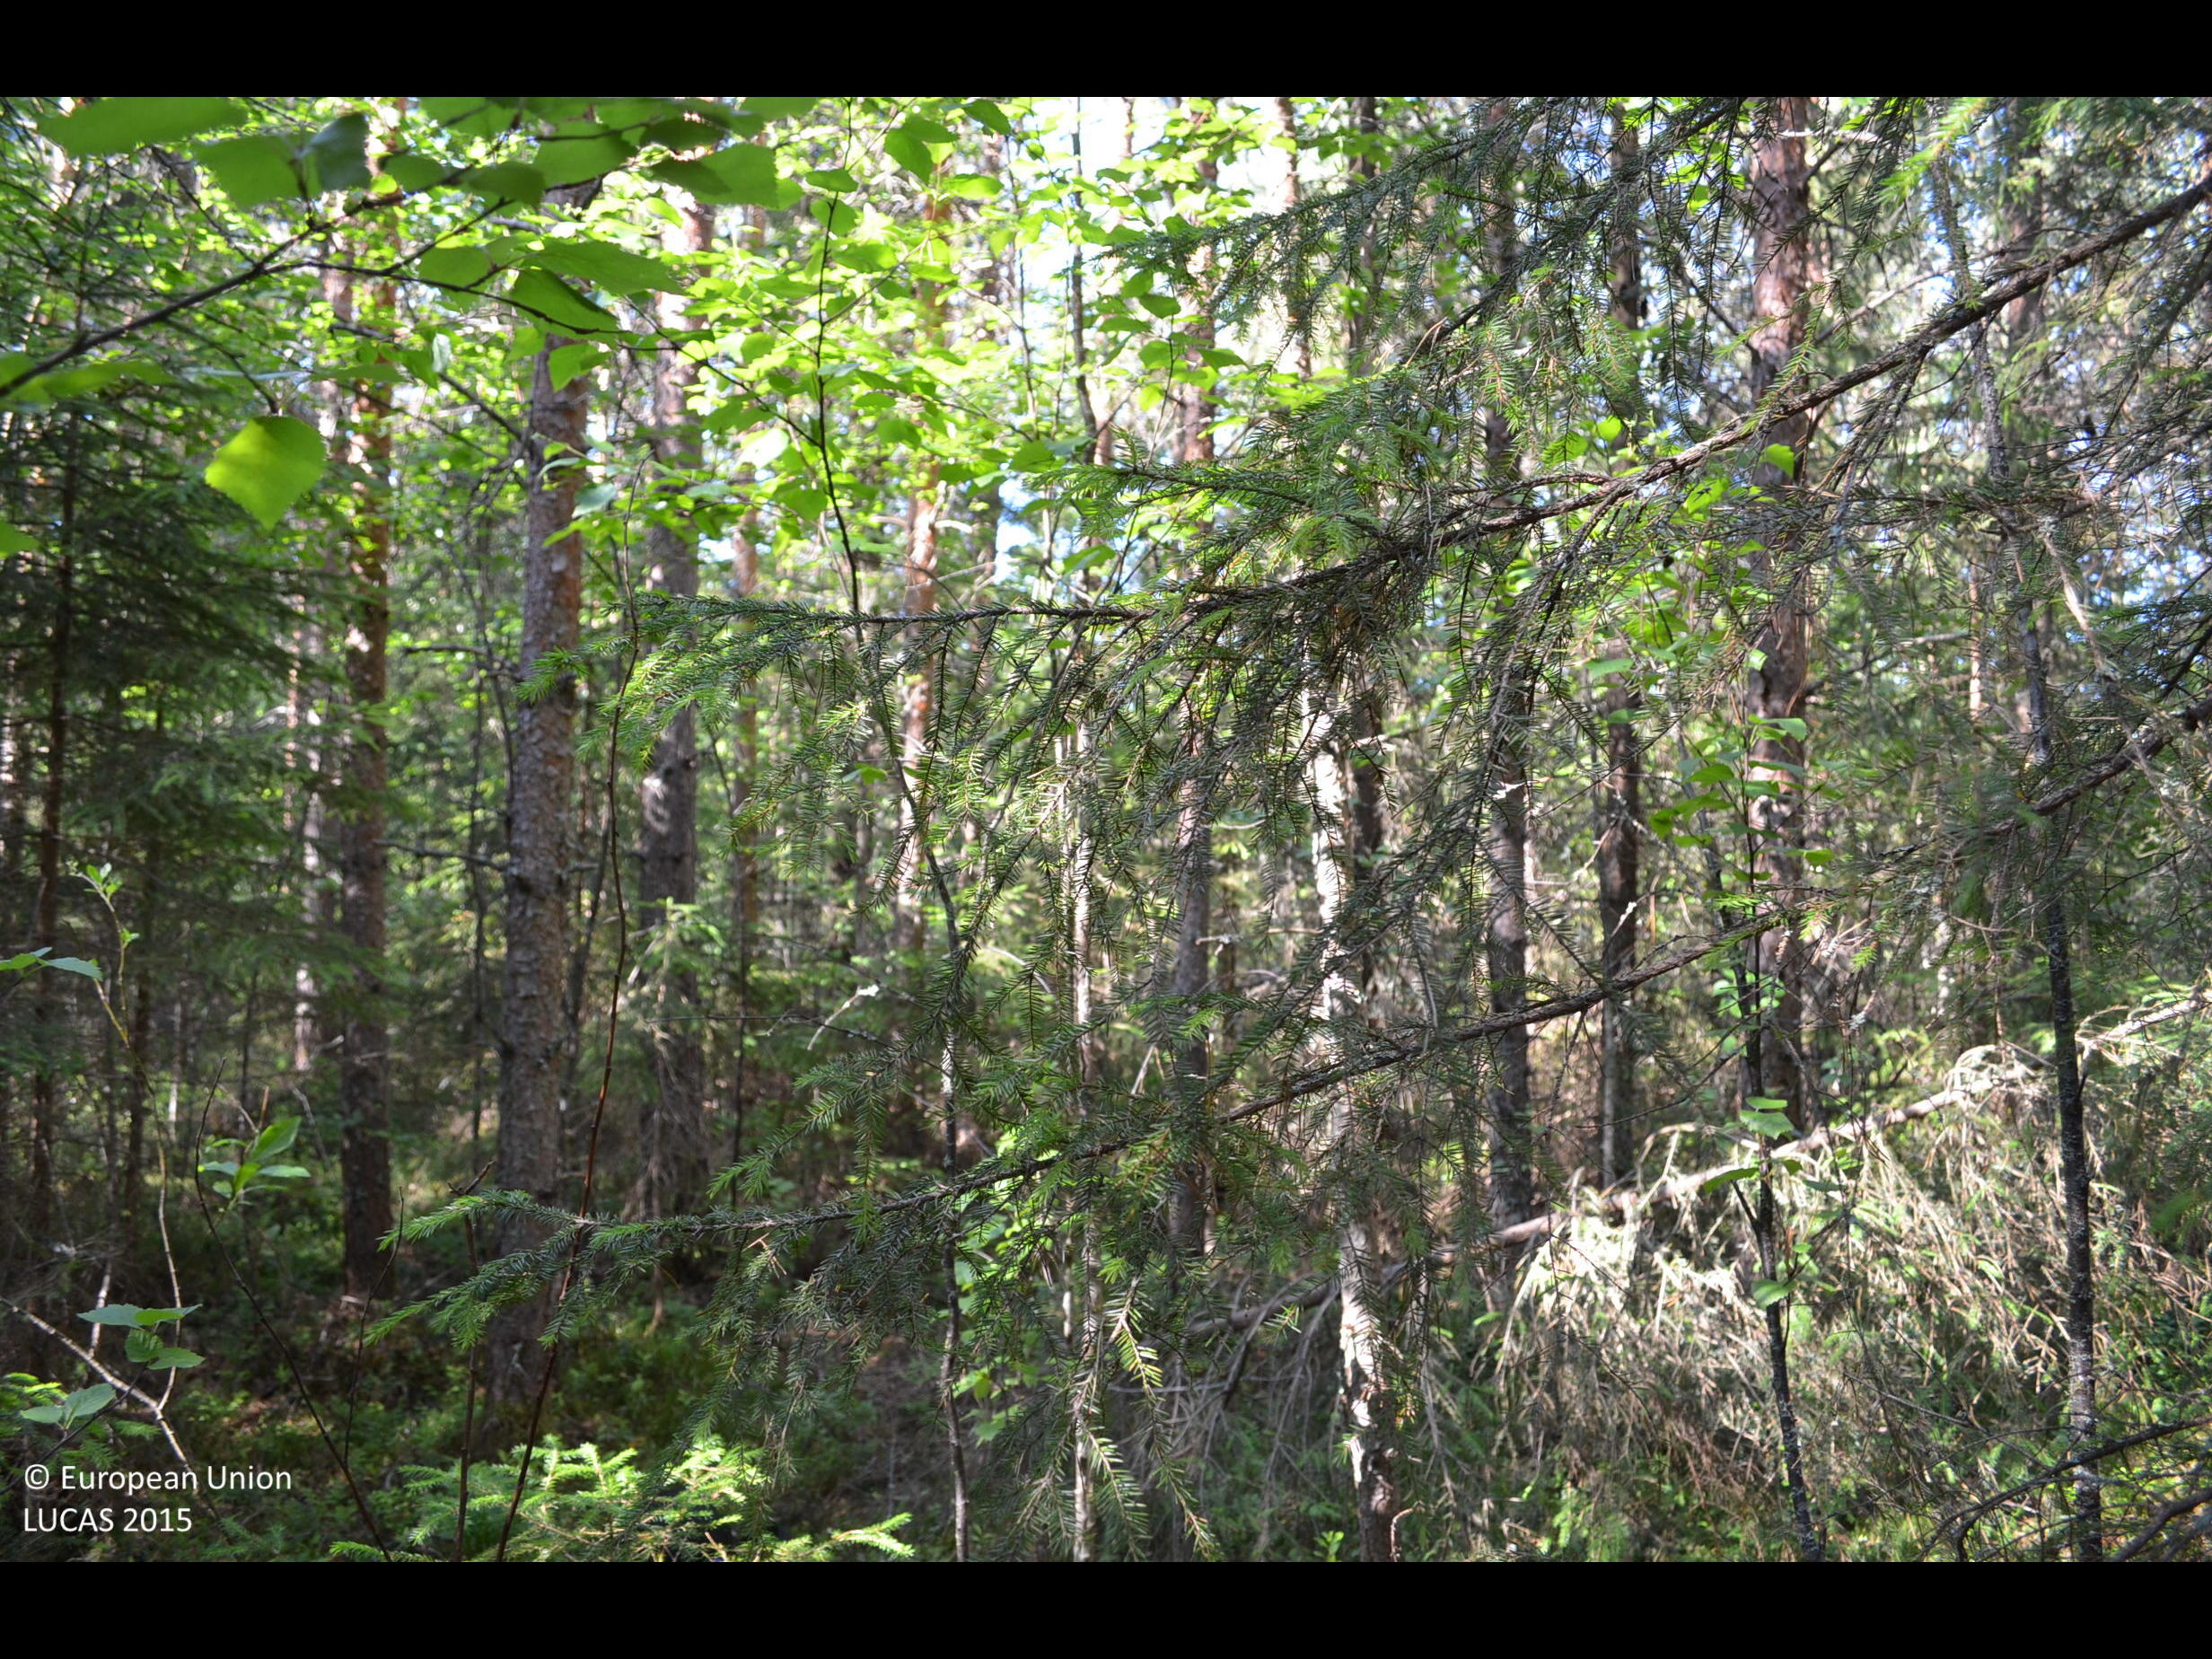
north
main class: Woodland
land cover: Pine dominated coniferous woodland
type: boreal forest
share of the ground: > 75 %
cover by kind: coniferous forest trees 90 %, broadleaved forest trees 5 %, shrubs 5 %
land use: Forestry
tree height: > 5 m
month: July
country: FI
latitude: 61.8035
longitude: 23.4512
